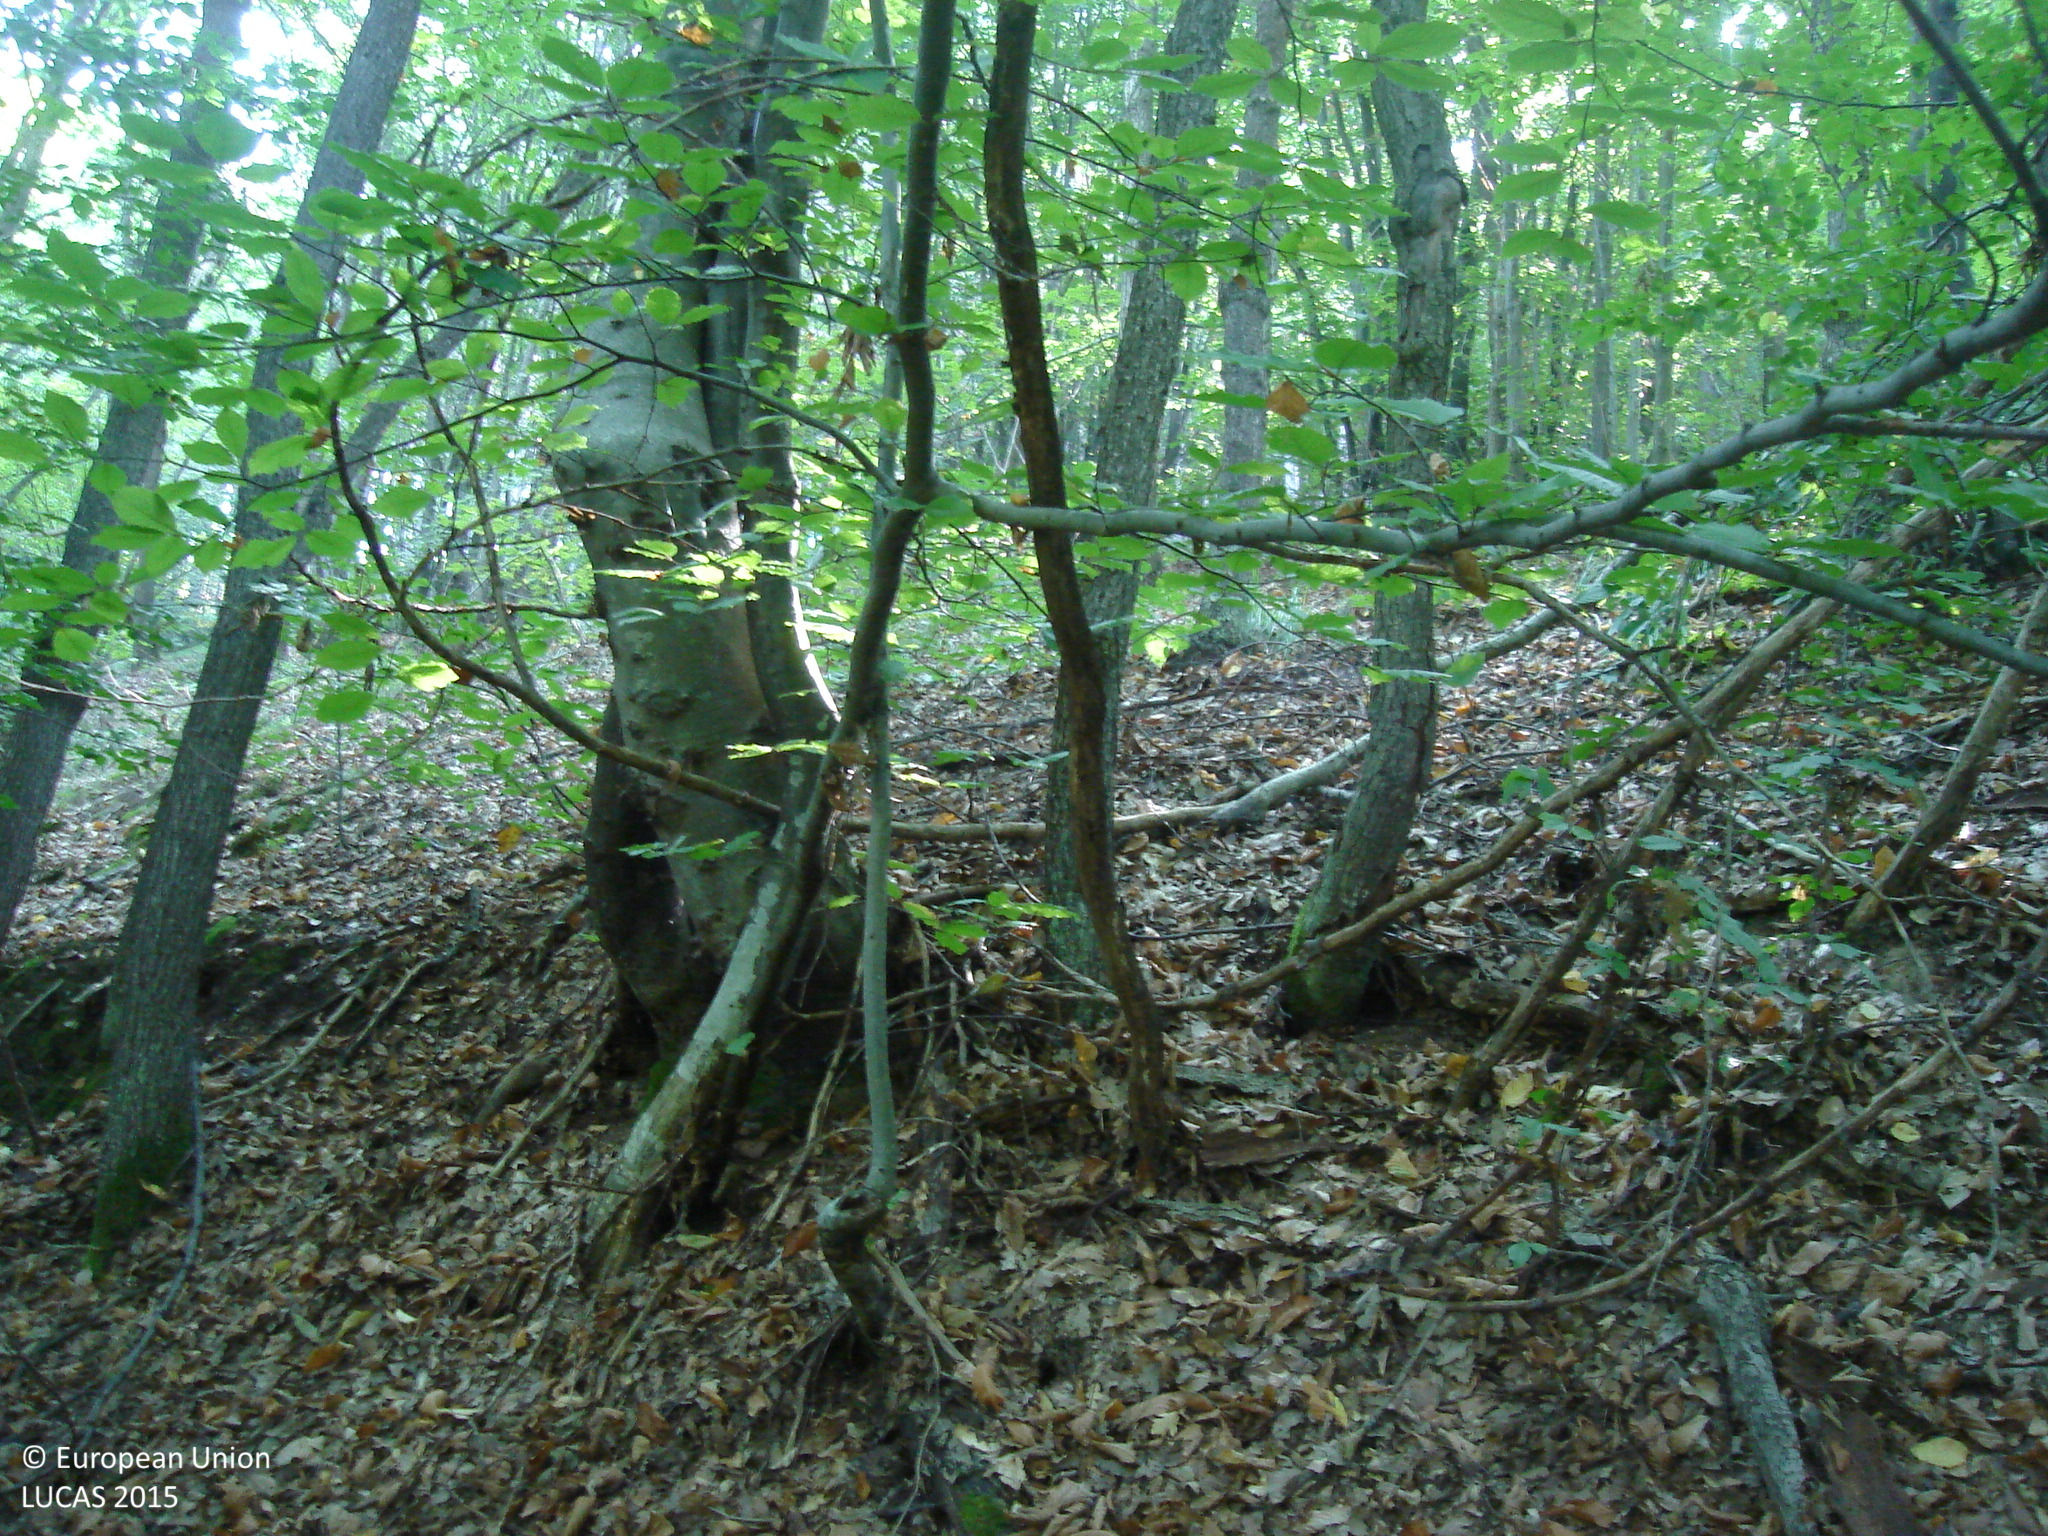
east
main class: Woodland
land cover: Broadleaved woodland
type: thermophilous deciduous forest
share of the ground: > 75 %
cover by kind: broadleaved forest trees 100 %
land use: Forestry
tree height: > 5 m
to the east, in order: Broadleaved woodland; Pine dominated coniferous woodland; Pine dominated mixed woodland
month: September
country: BG
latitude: 42.8973
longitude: 23.2241
